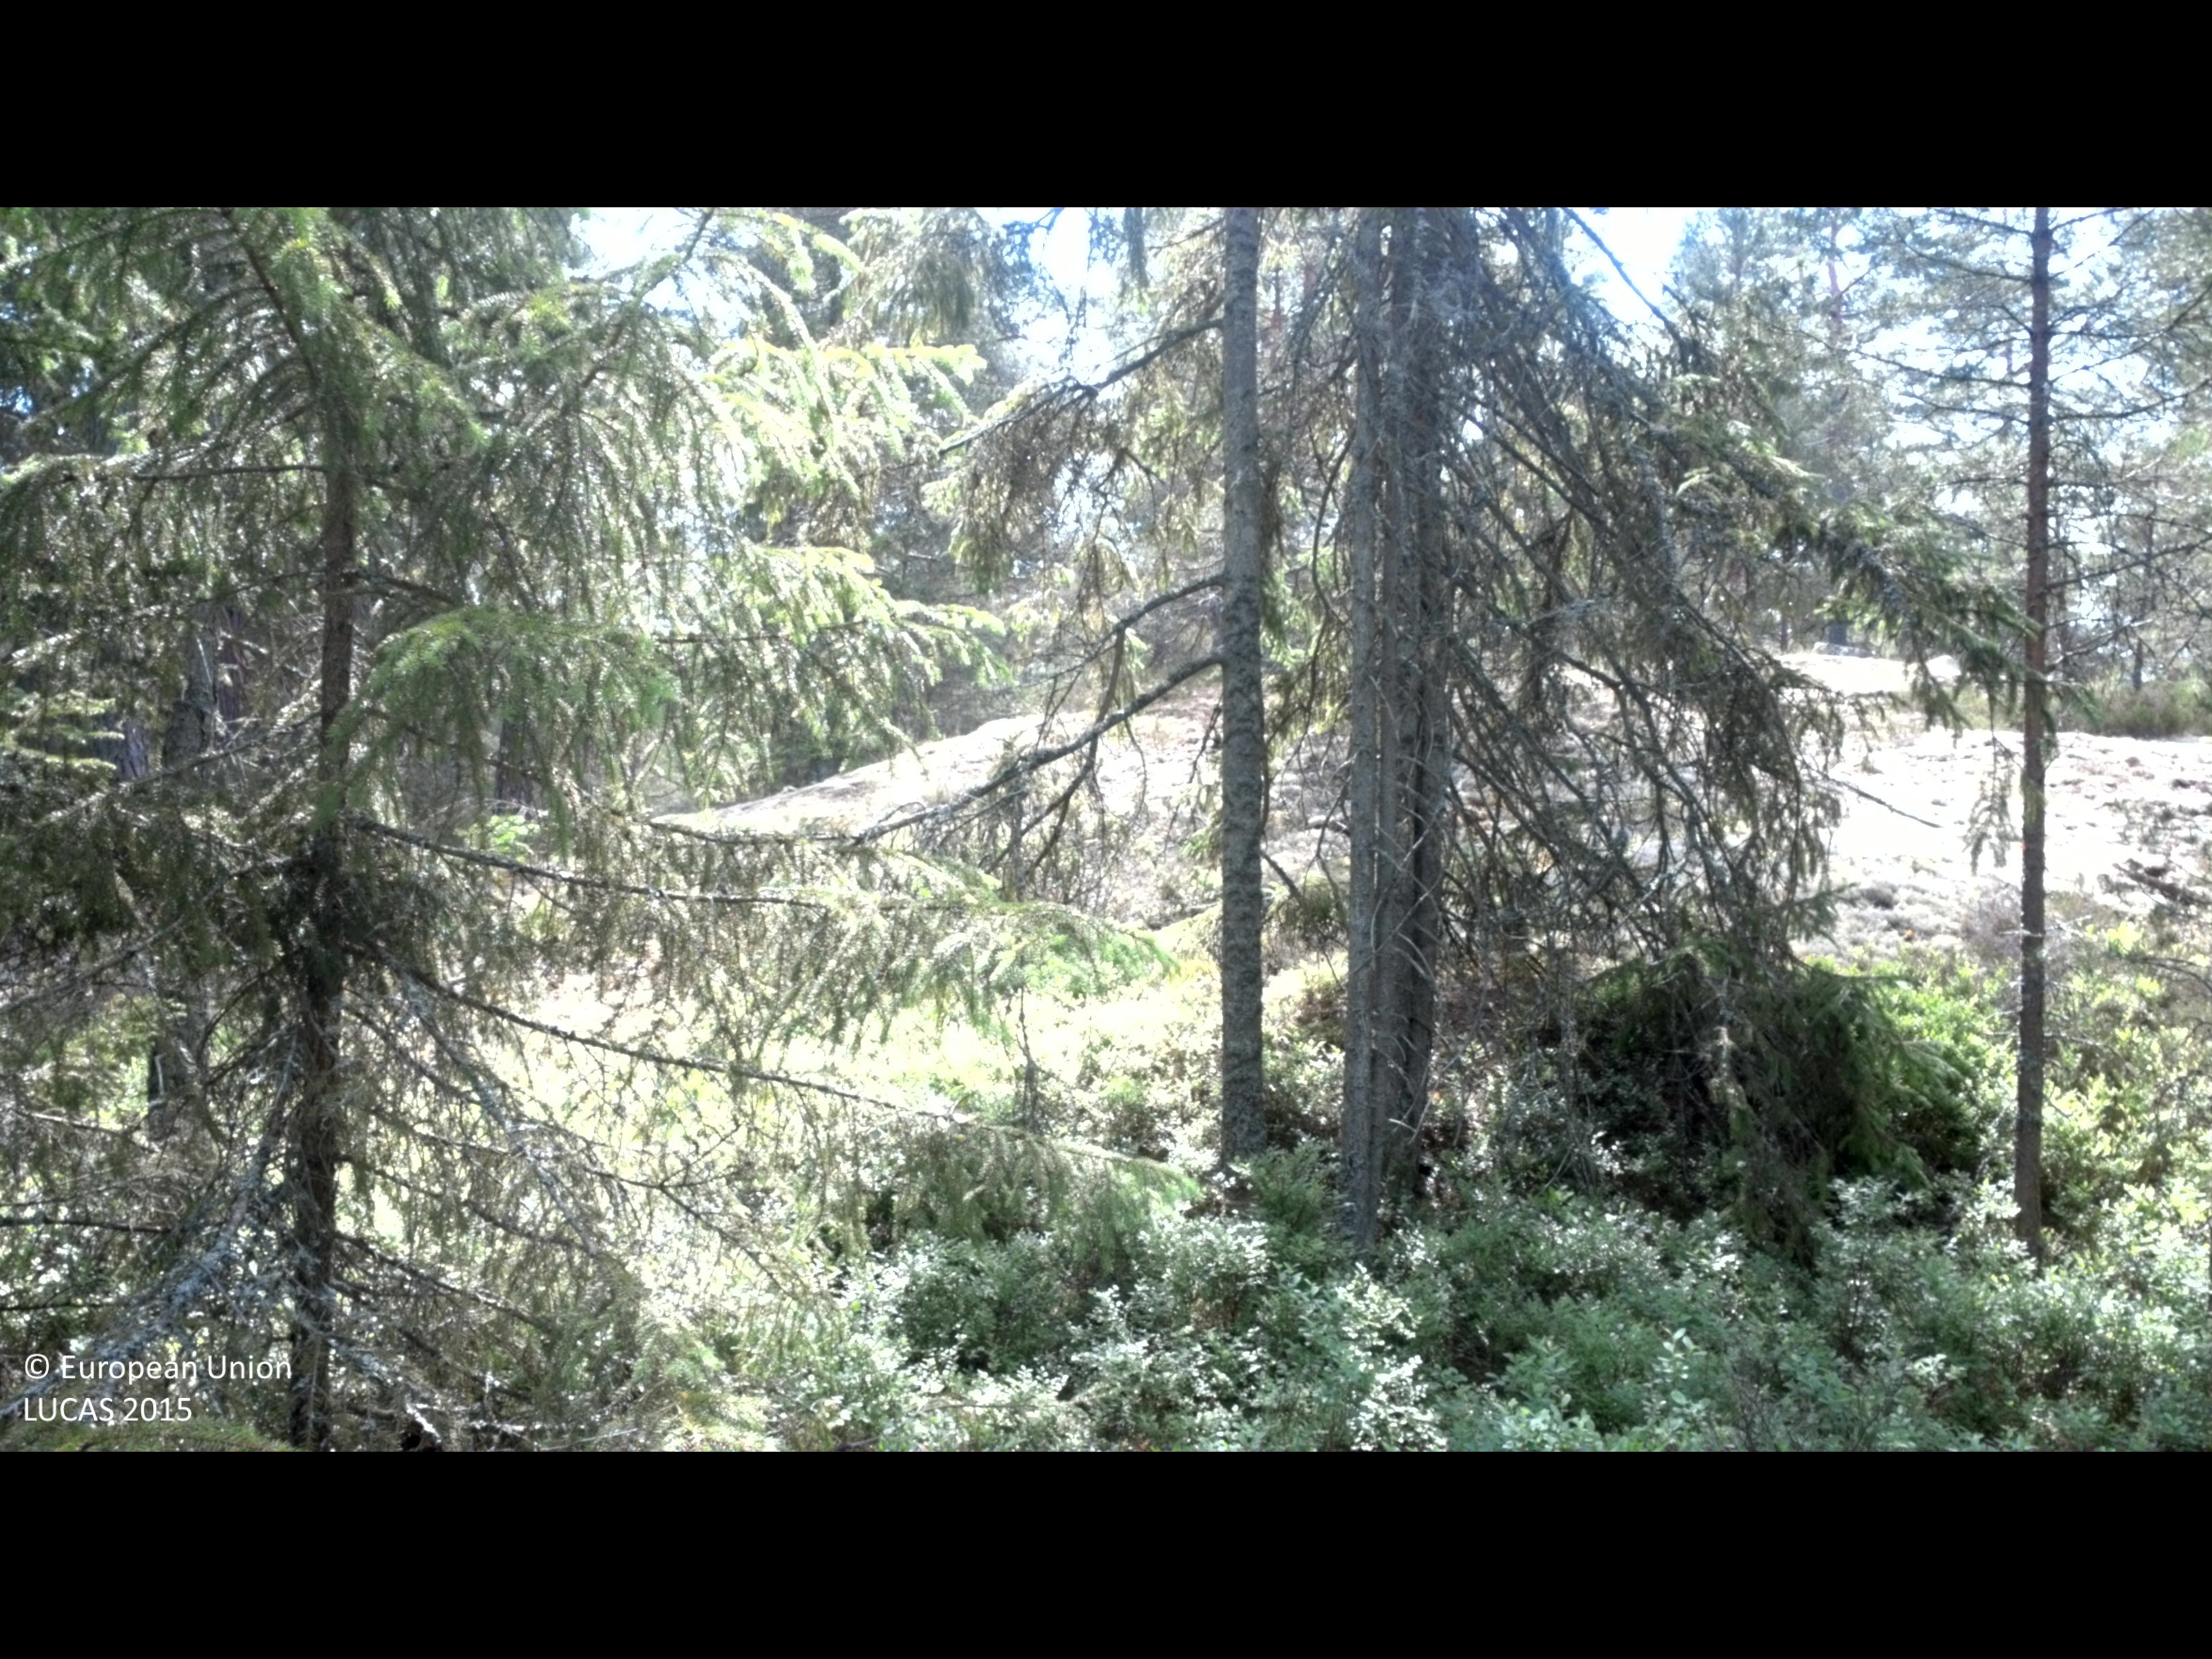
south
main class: Woodland
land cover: Other coniferous woodland
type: boreal forest
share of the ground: 50 - 75 %
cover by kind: coniferous forest trees 50 %, shrubs 30 %, lichens and mosses 15 %, broadleaved forest trees 5 %
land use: Forestry
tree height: > 5 m
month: June
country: SE
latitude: 57.6268
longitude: 16.5464
